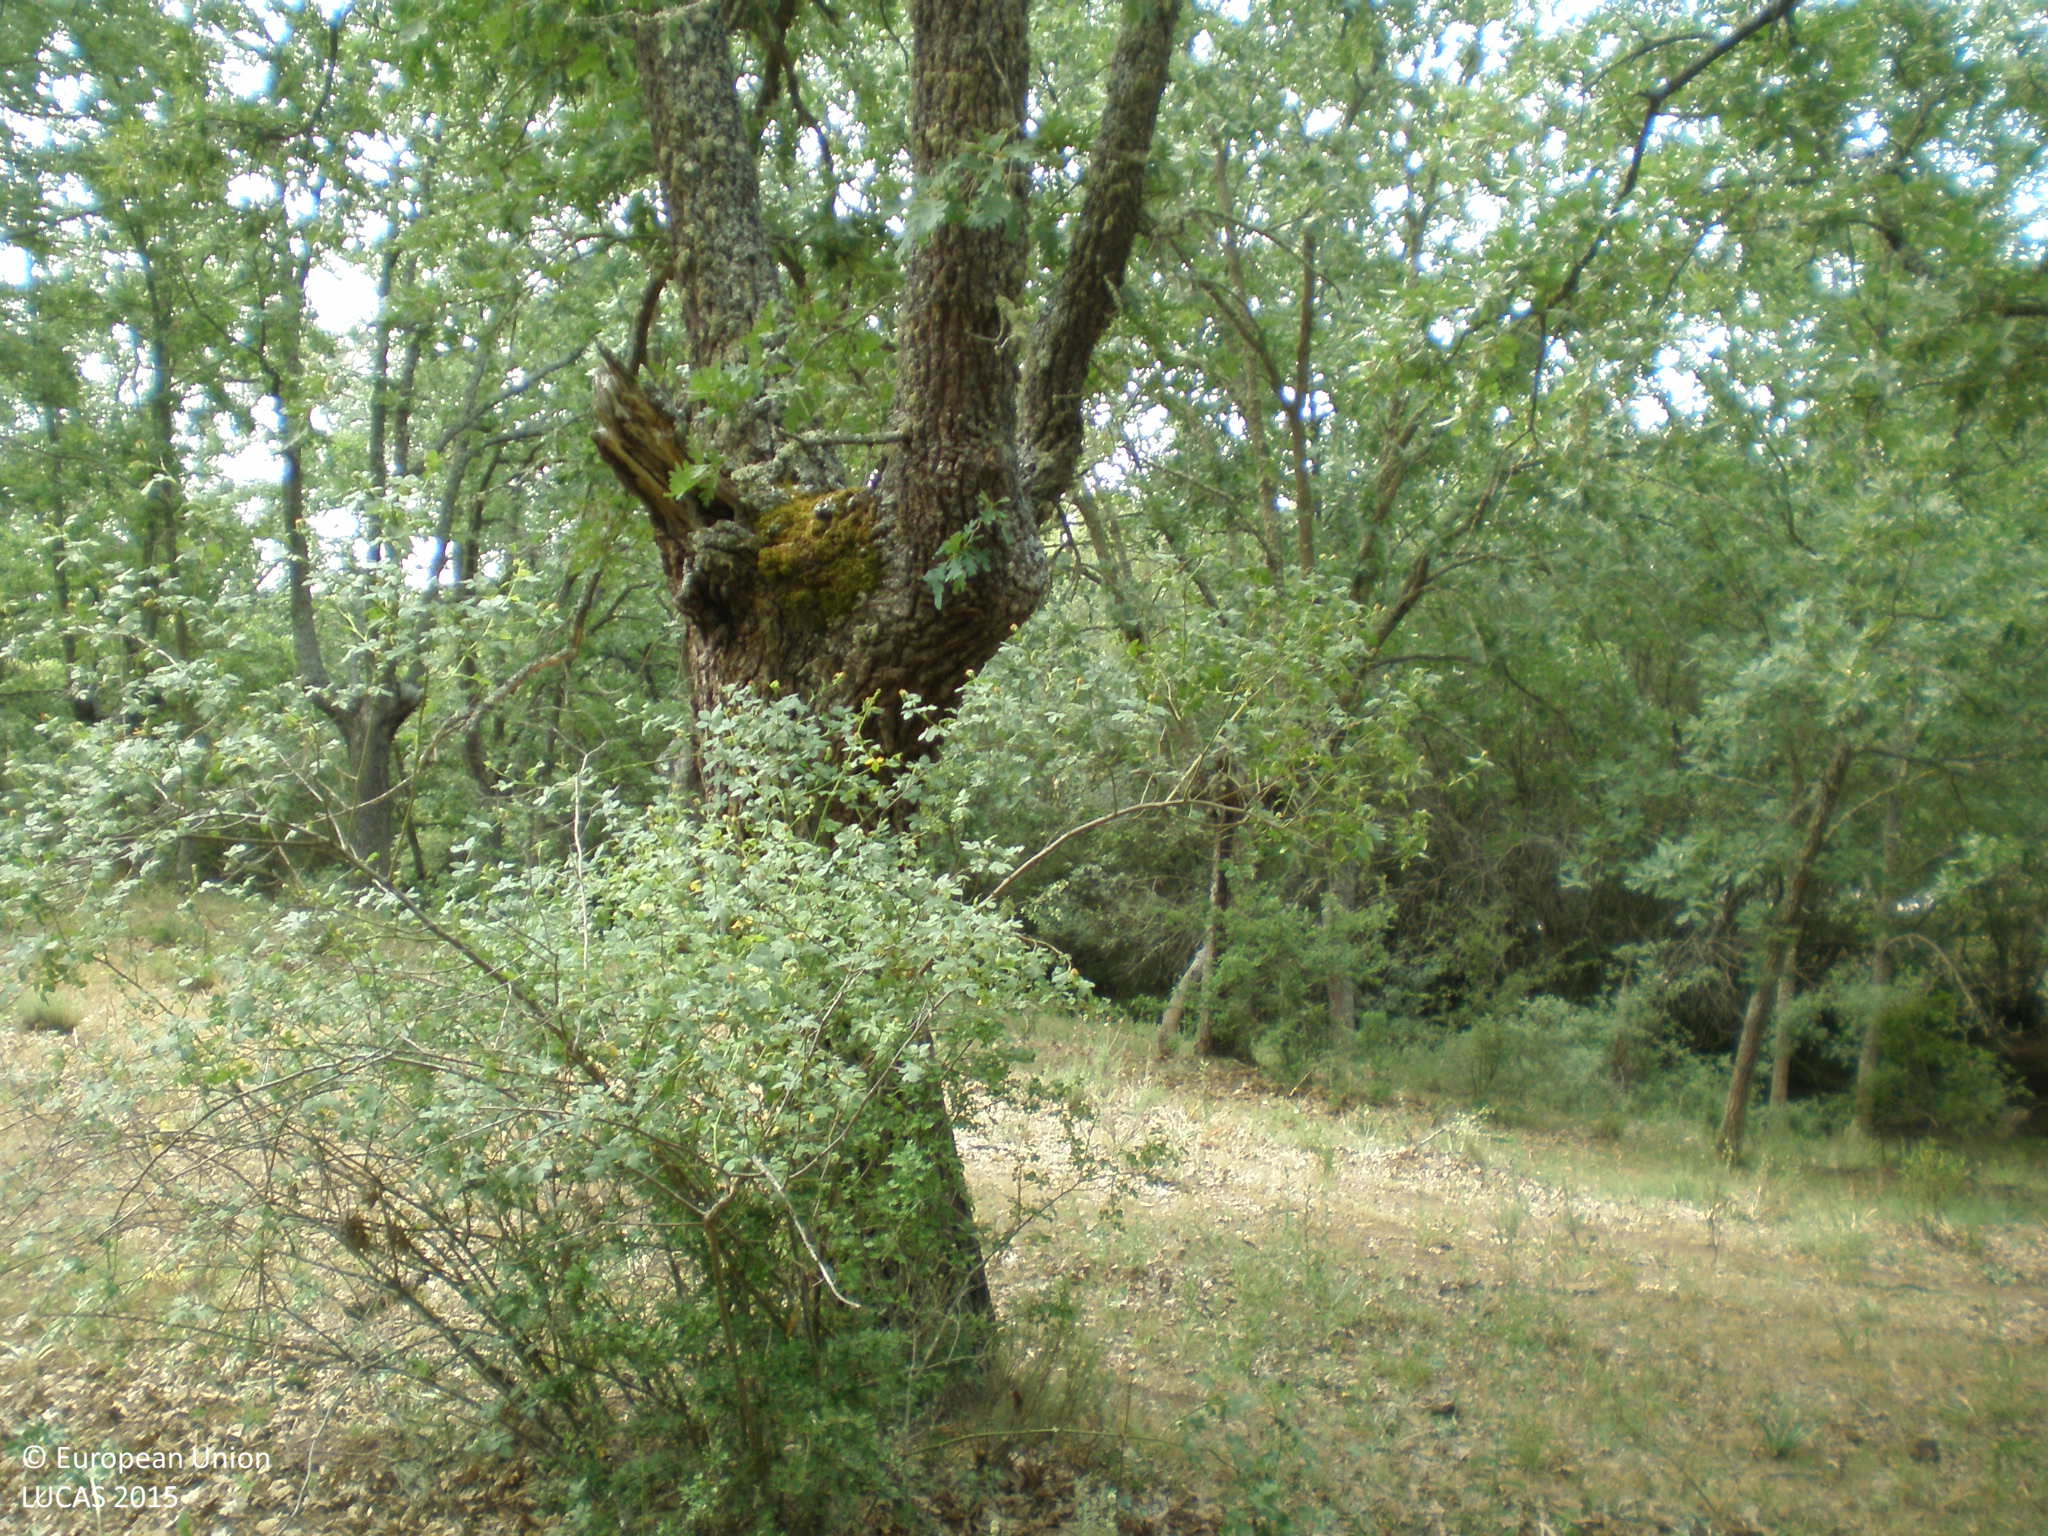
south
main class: Woodland
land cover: Broadleaved woodland
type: thermophilous deciduous forest
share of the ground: > 75 %
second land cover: Grassland without tree/shrub cover
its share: 10 - 25 %
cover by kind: broadleaved forest trees 80 %, herbaceous plants 20 %
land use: Forestry
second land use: Agriculture (excluding fallow land and kitchen gardens)
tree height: > 5 m
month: June
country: ES
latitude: 41.2183
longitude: -5.8169
